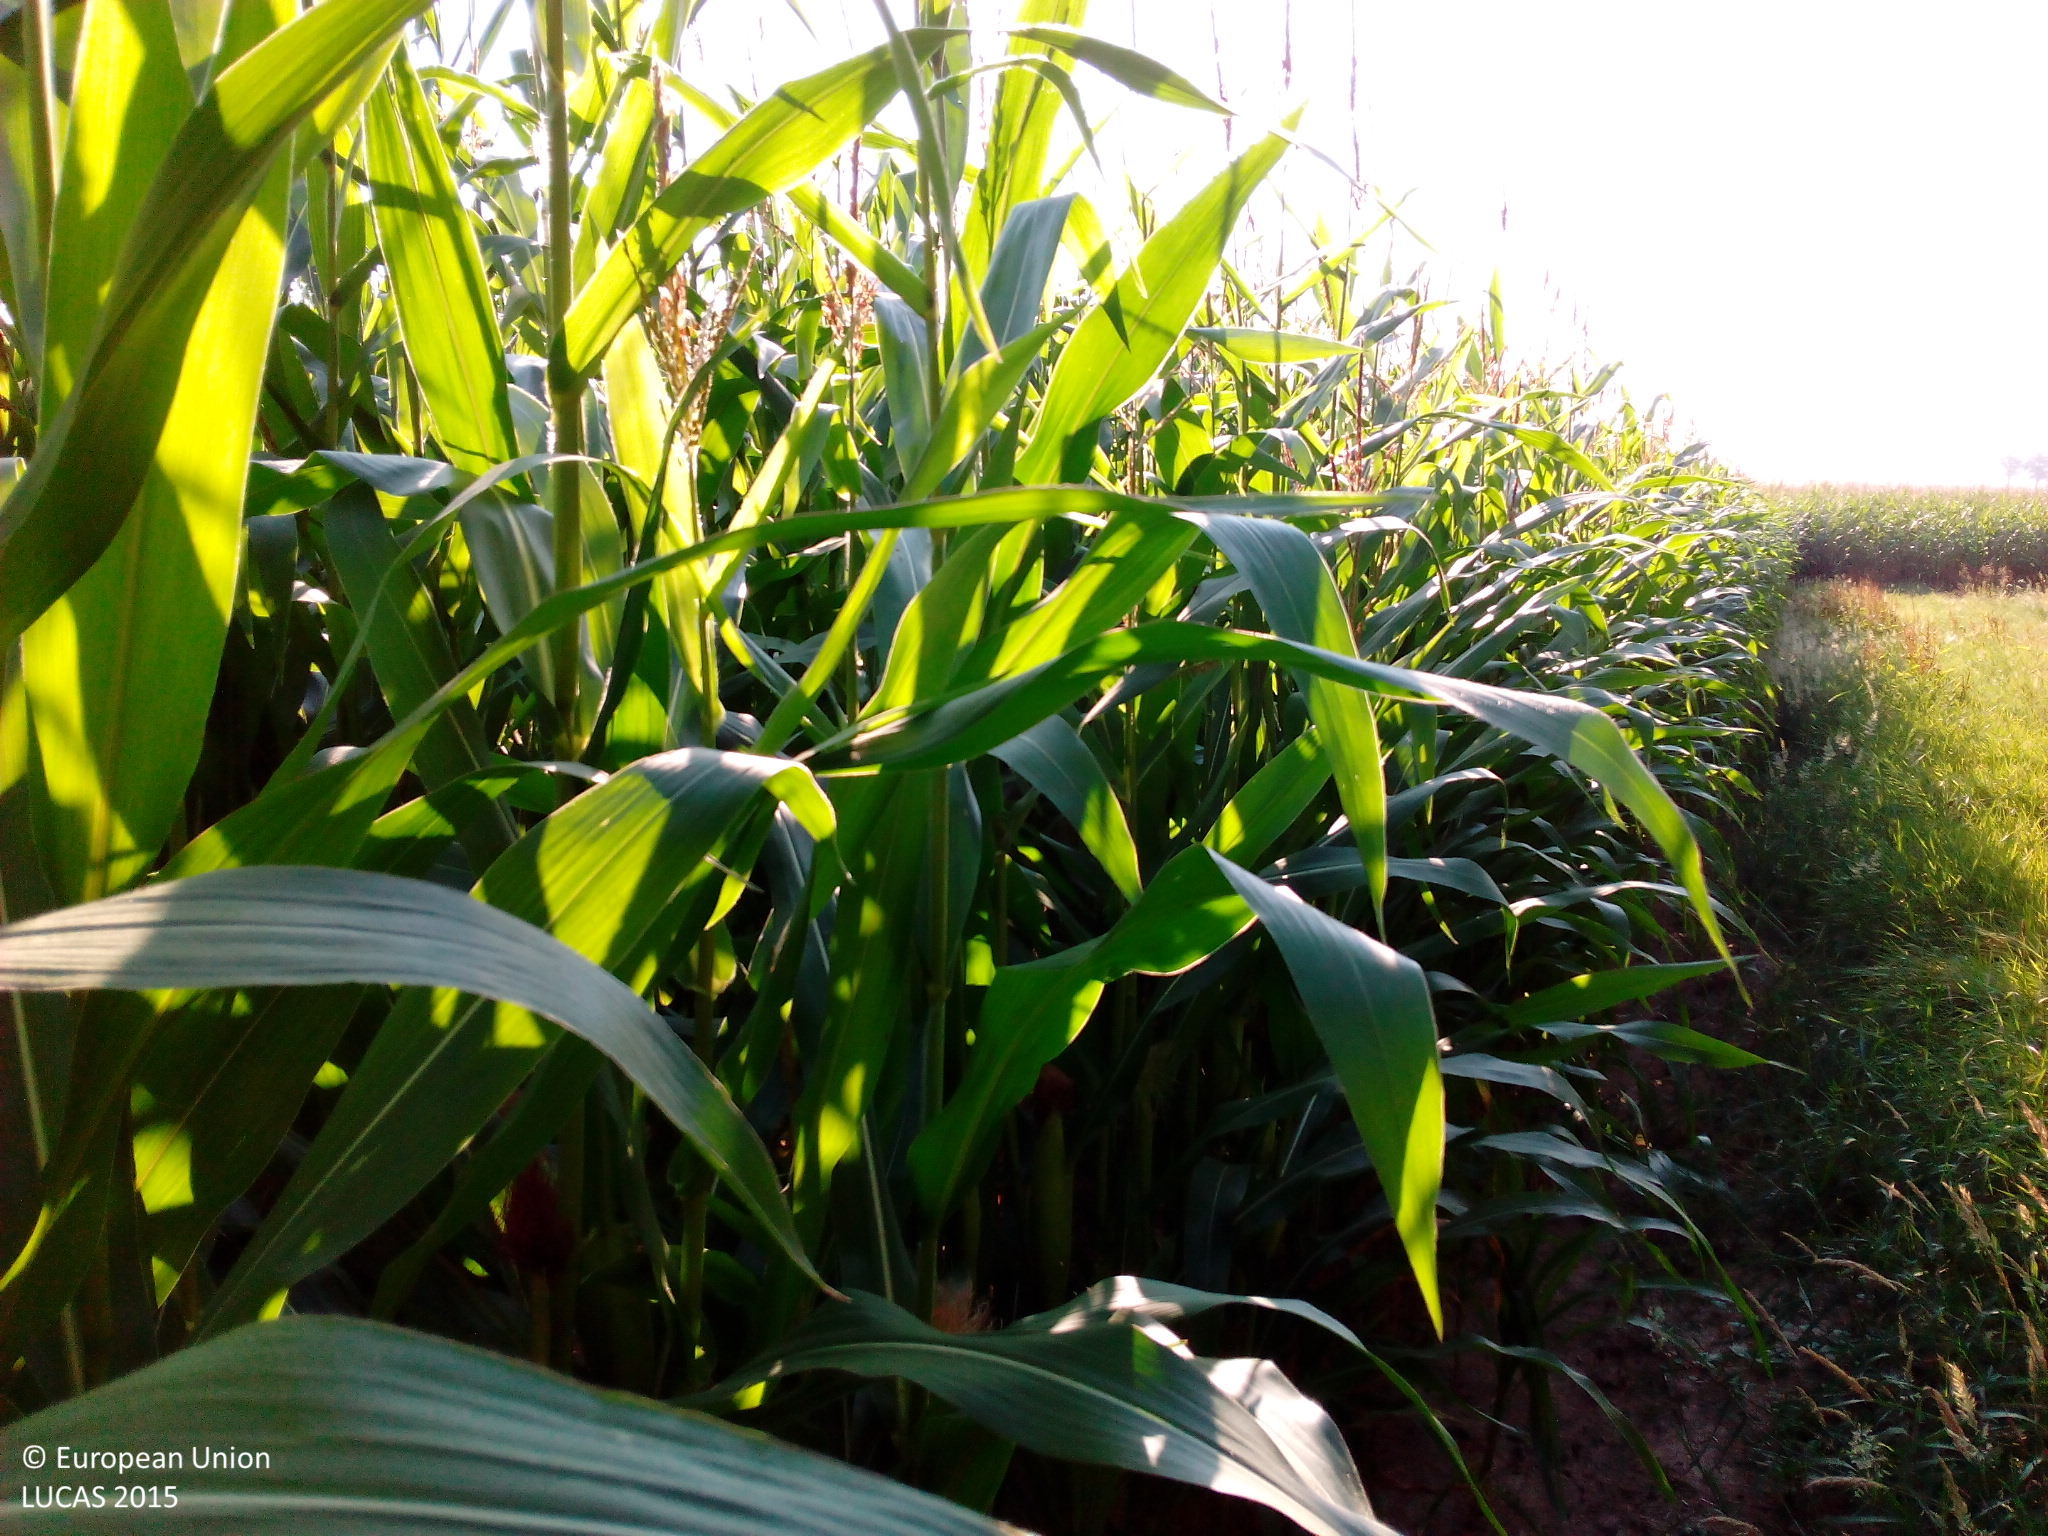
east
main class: Cropland
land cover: Maize
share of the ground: > 75 %
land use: Agriculture (excluding fallow land and kitchen gardens)
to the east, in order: Maize; Grass margins; Tracks; Grass margins; Common wheat
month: August
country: DE
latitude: 48.7441
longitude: 10.5301
